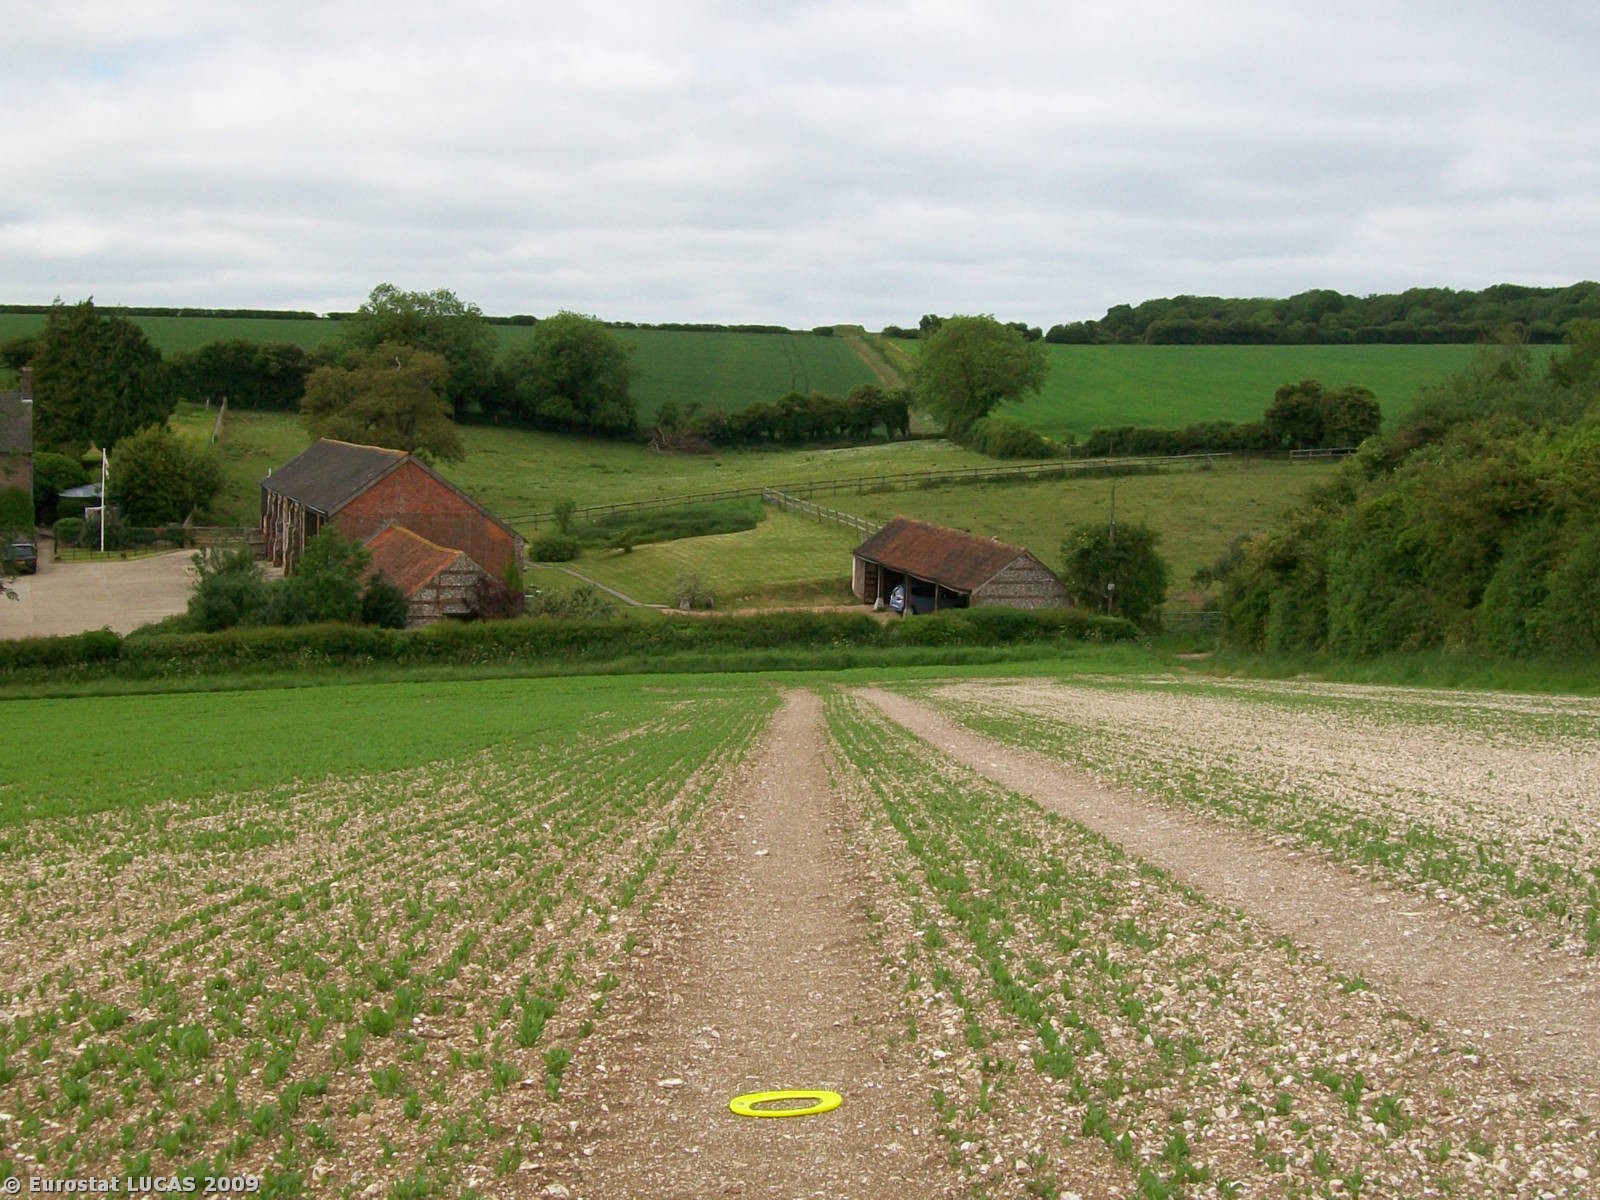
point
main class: Cropland
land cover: Other fibre and oleaginous crops
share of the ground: 25 - 50 %
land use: Agriculture (excluding fallow land and kitchen gardens)
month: May
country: GB
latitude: 50.8976
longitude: -2.1317
